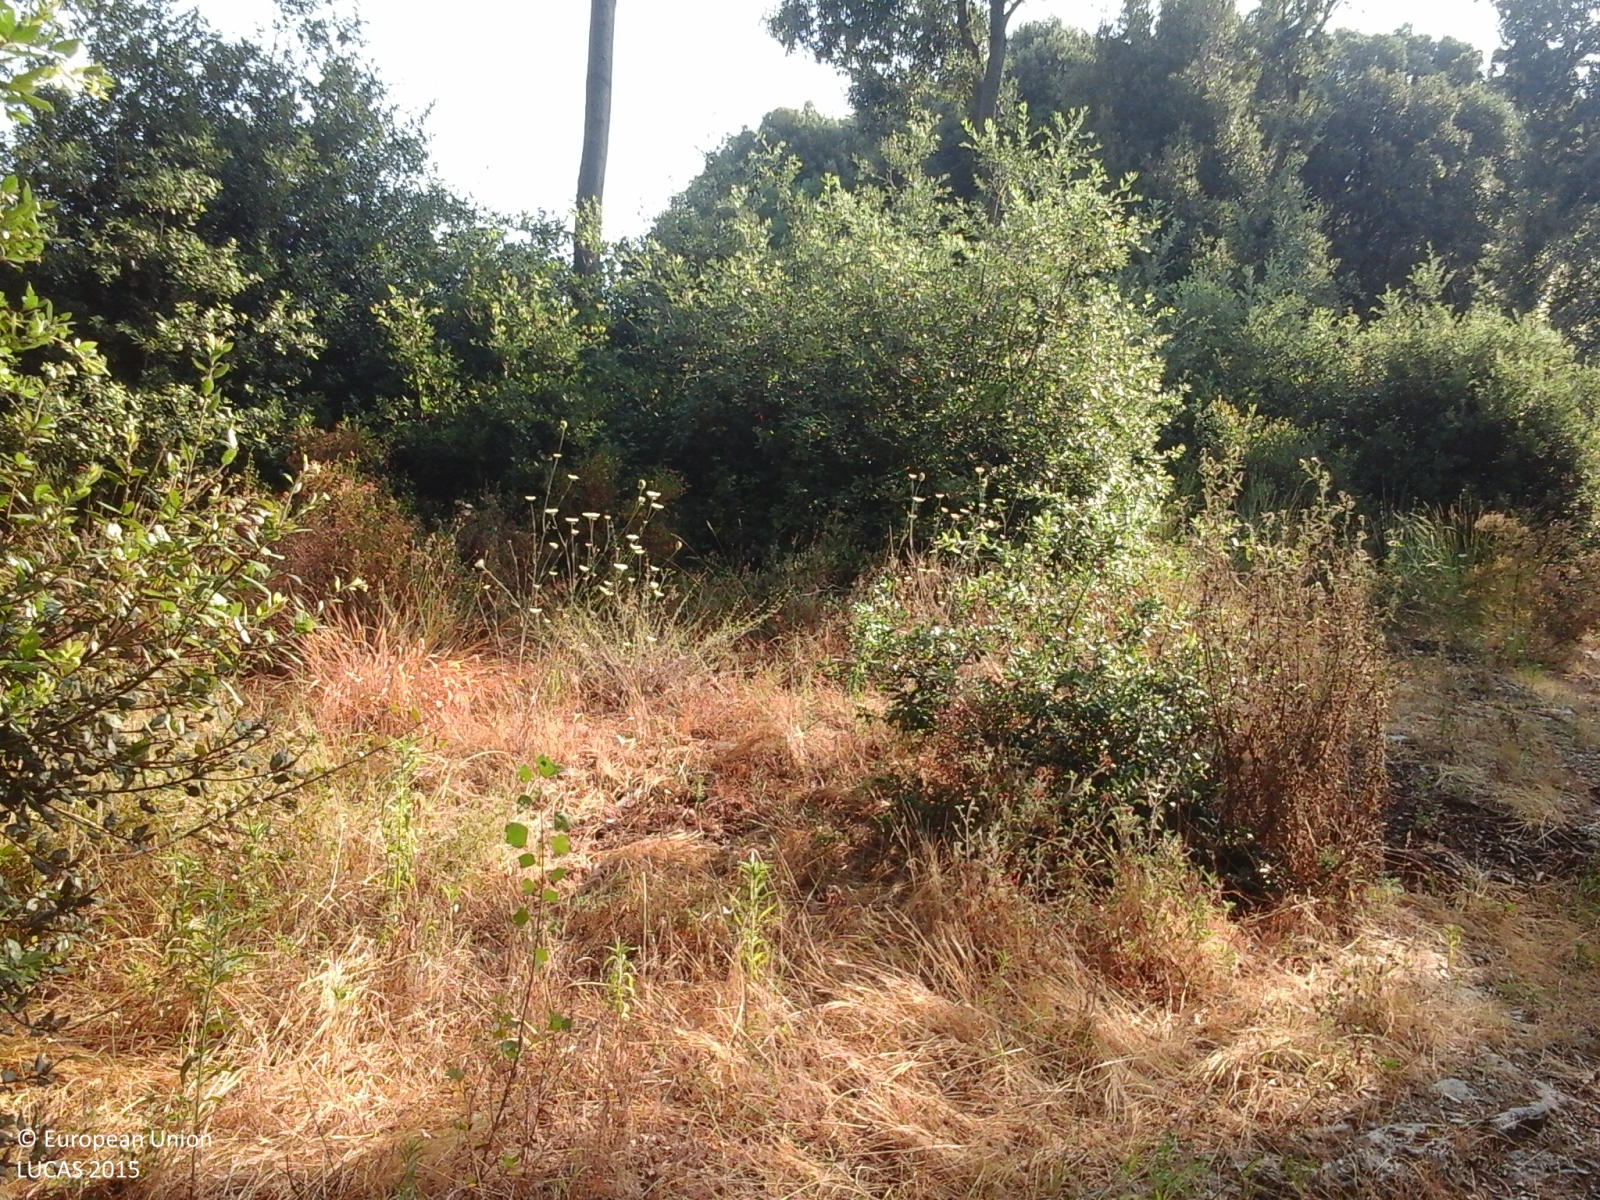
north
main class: Woodland
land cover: Broadleaved woodland
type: mesophytic deciduous forest
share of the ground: > 75 %
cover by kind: broadleaved forest trees 100 %
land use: Forestry
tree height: > 5 m
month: July
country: IT
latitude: 43.3157
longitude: 11.1434
